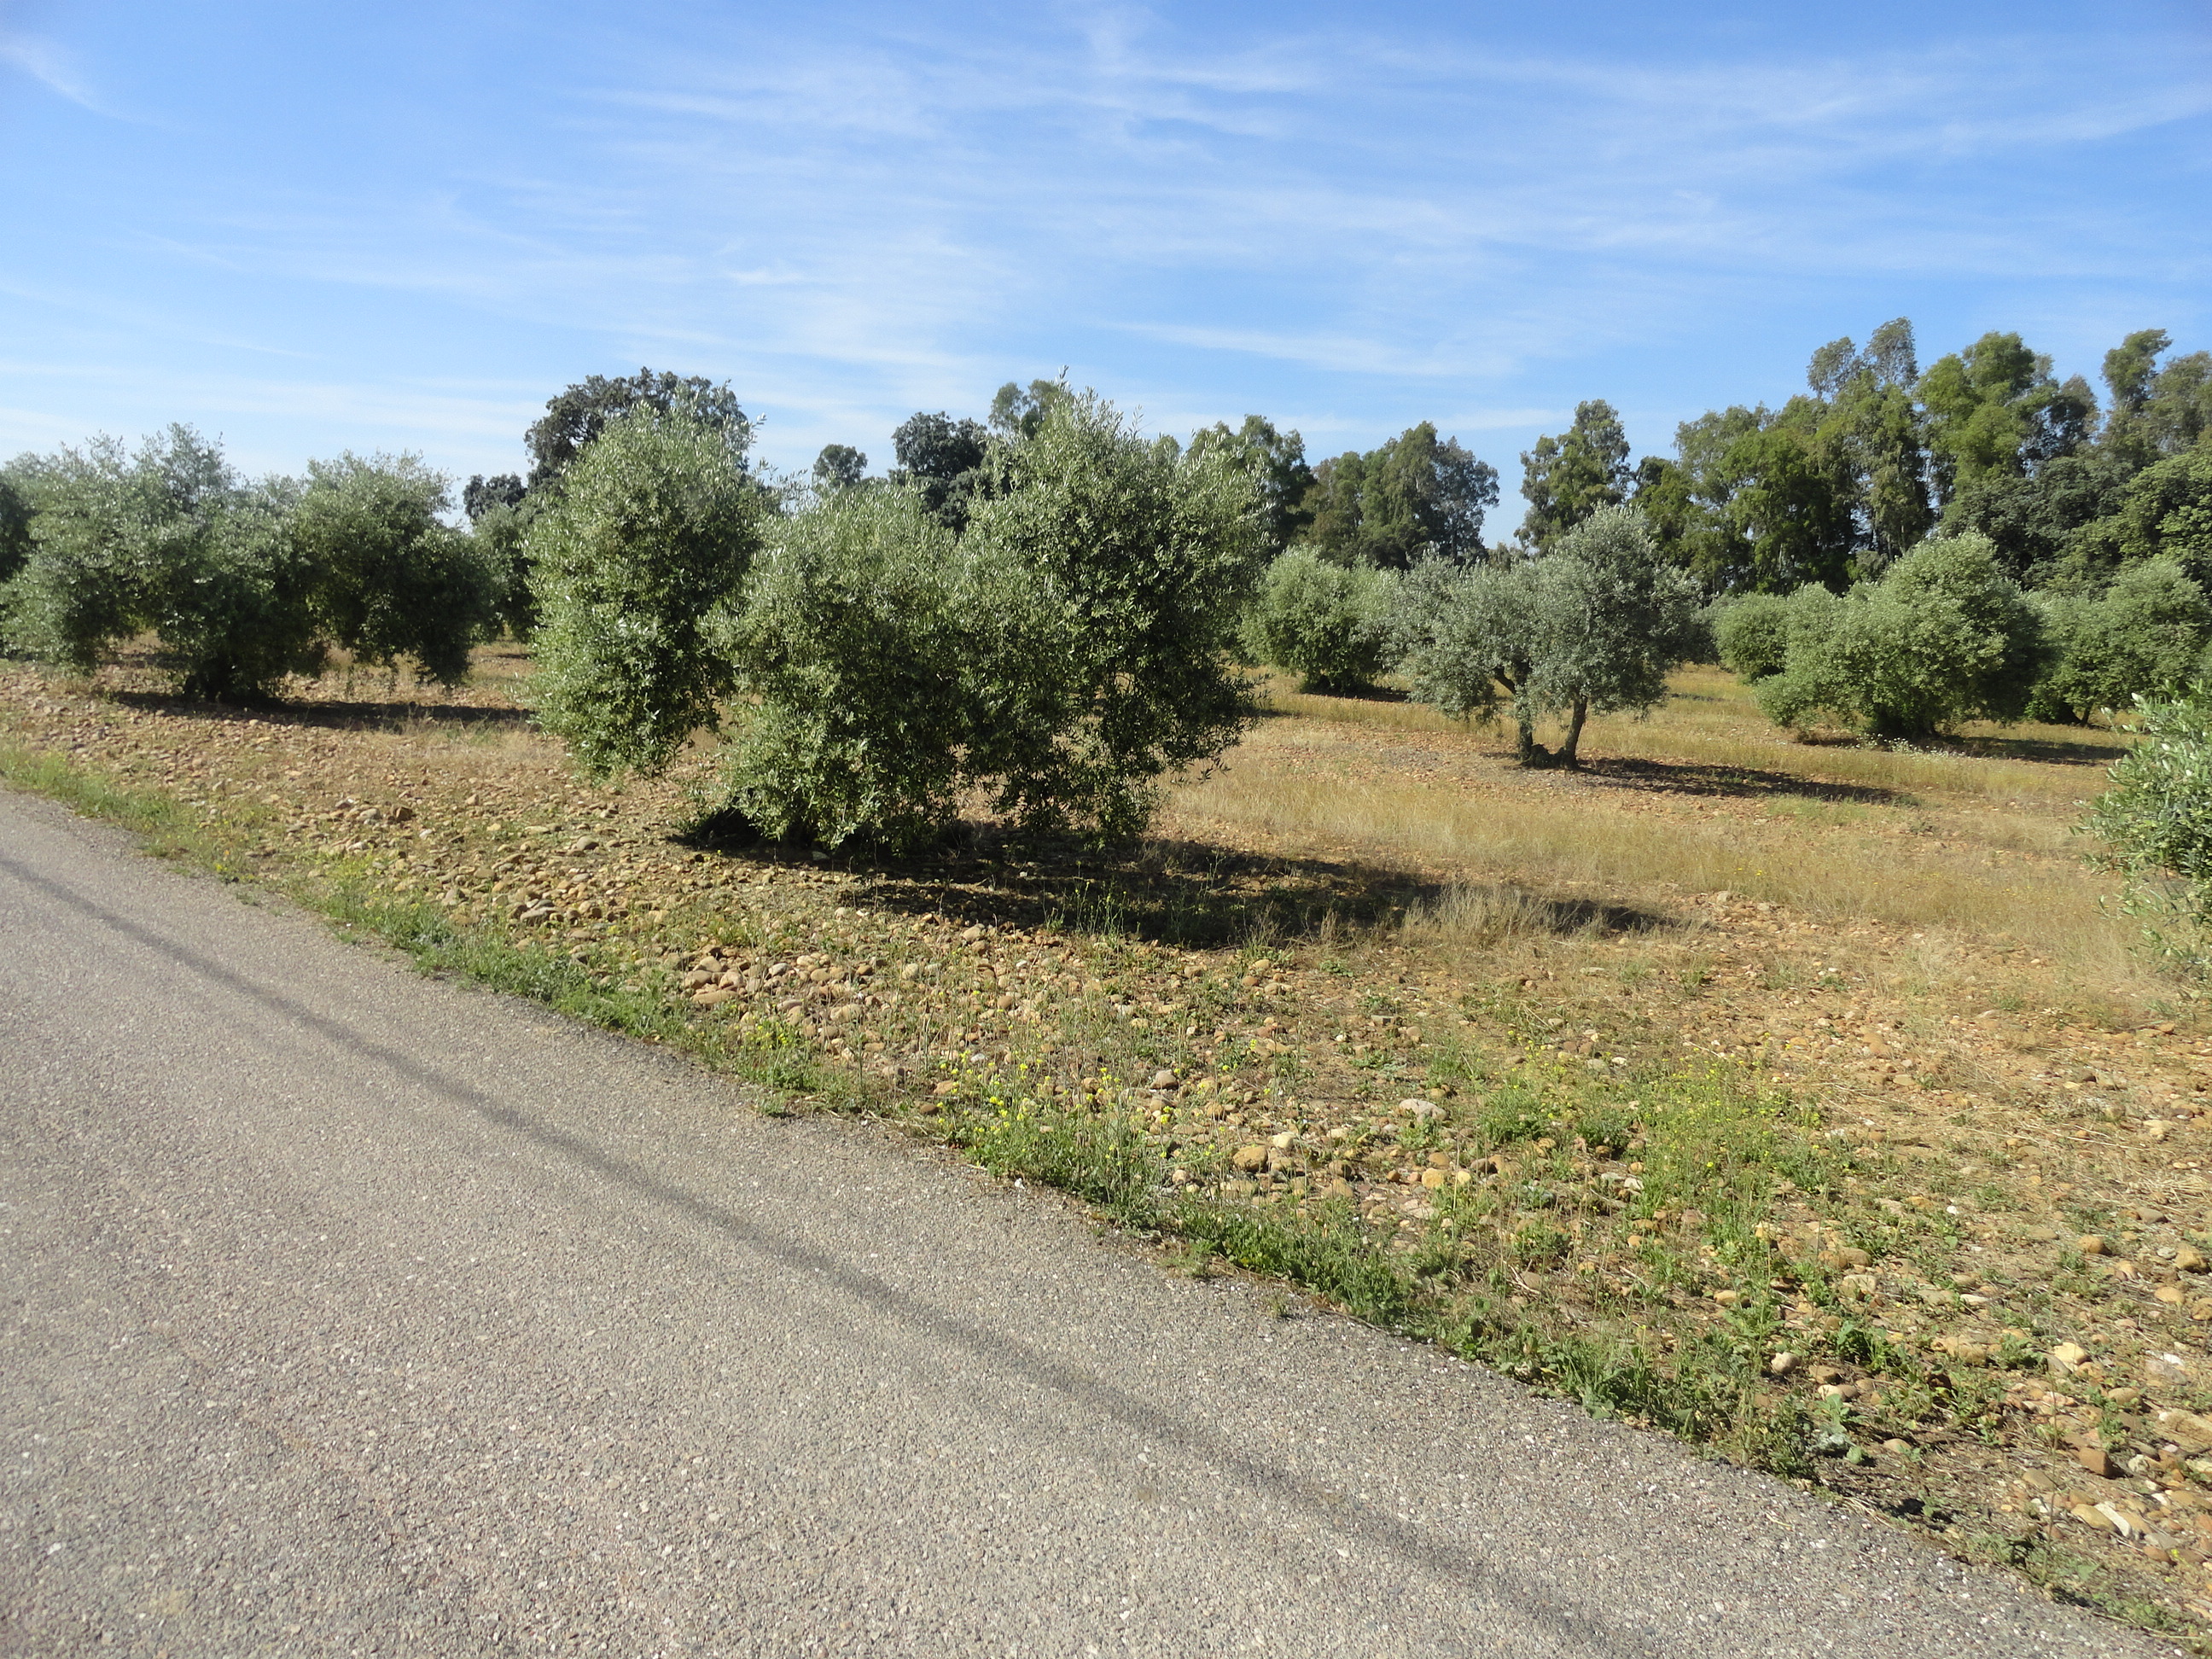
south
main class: Cropland
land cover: Olive groves
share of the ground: 10 - 25 %
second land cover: Other bare soil
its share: > 75 %
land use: Kitchen garden
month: May
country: ES
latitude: 37.7098
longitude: -4.8840
